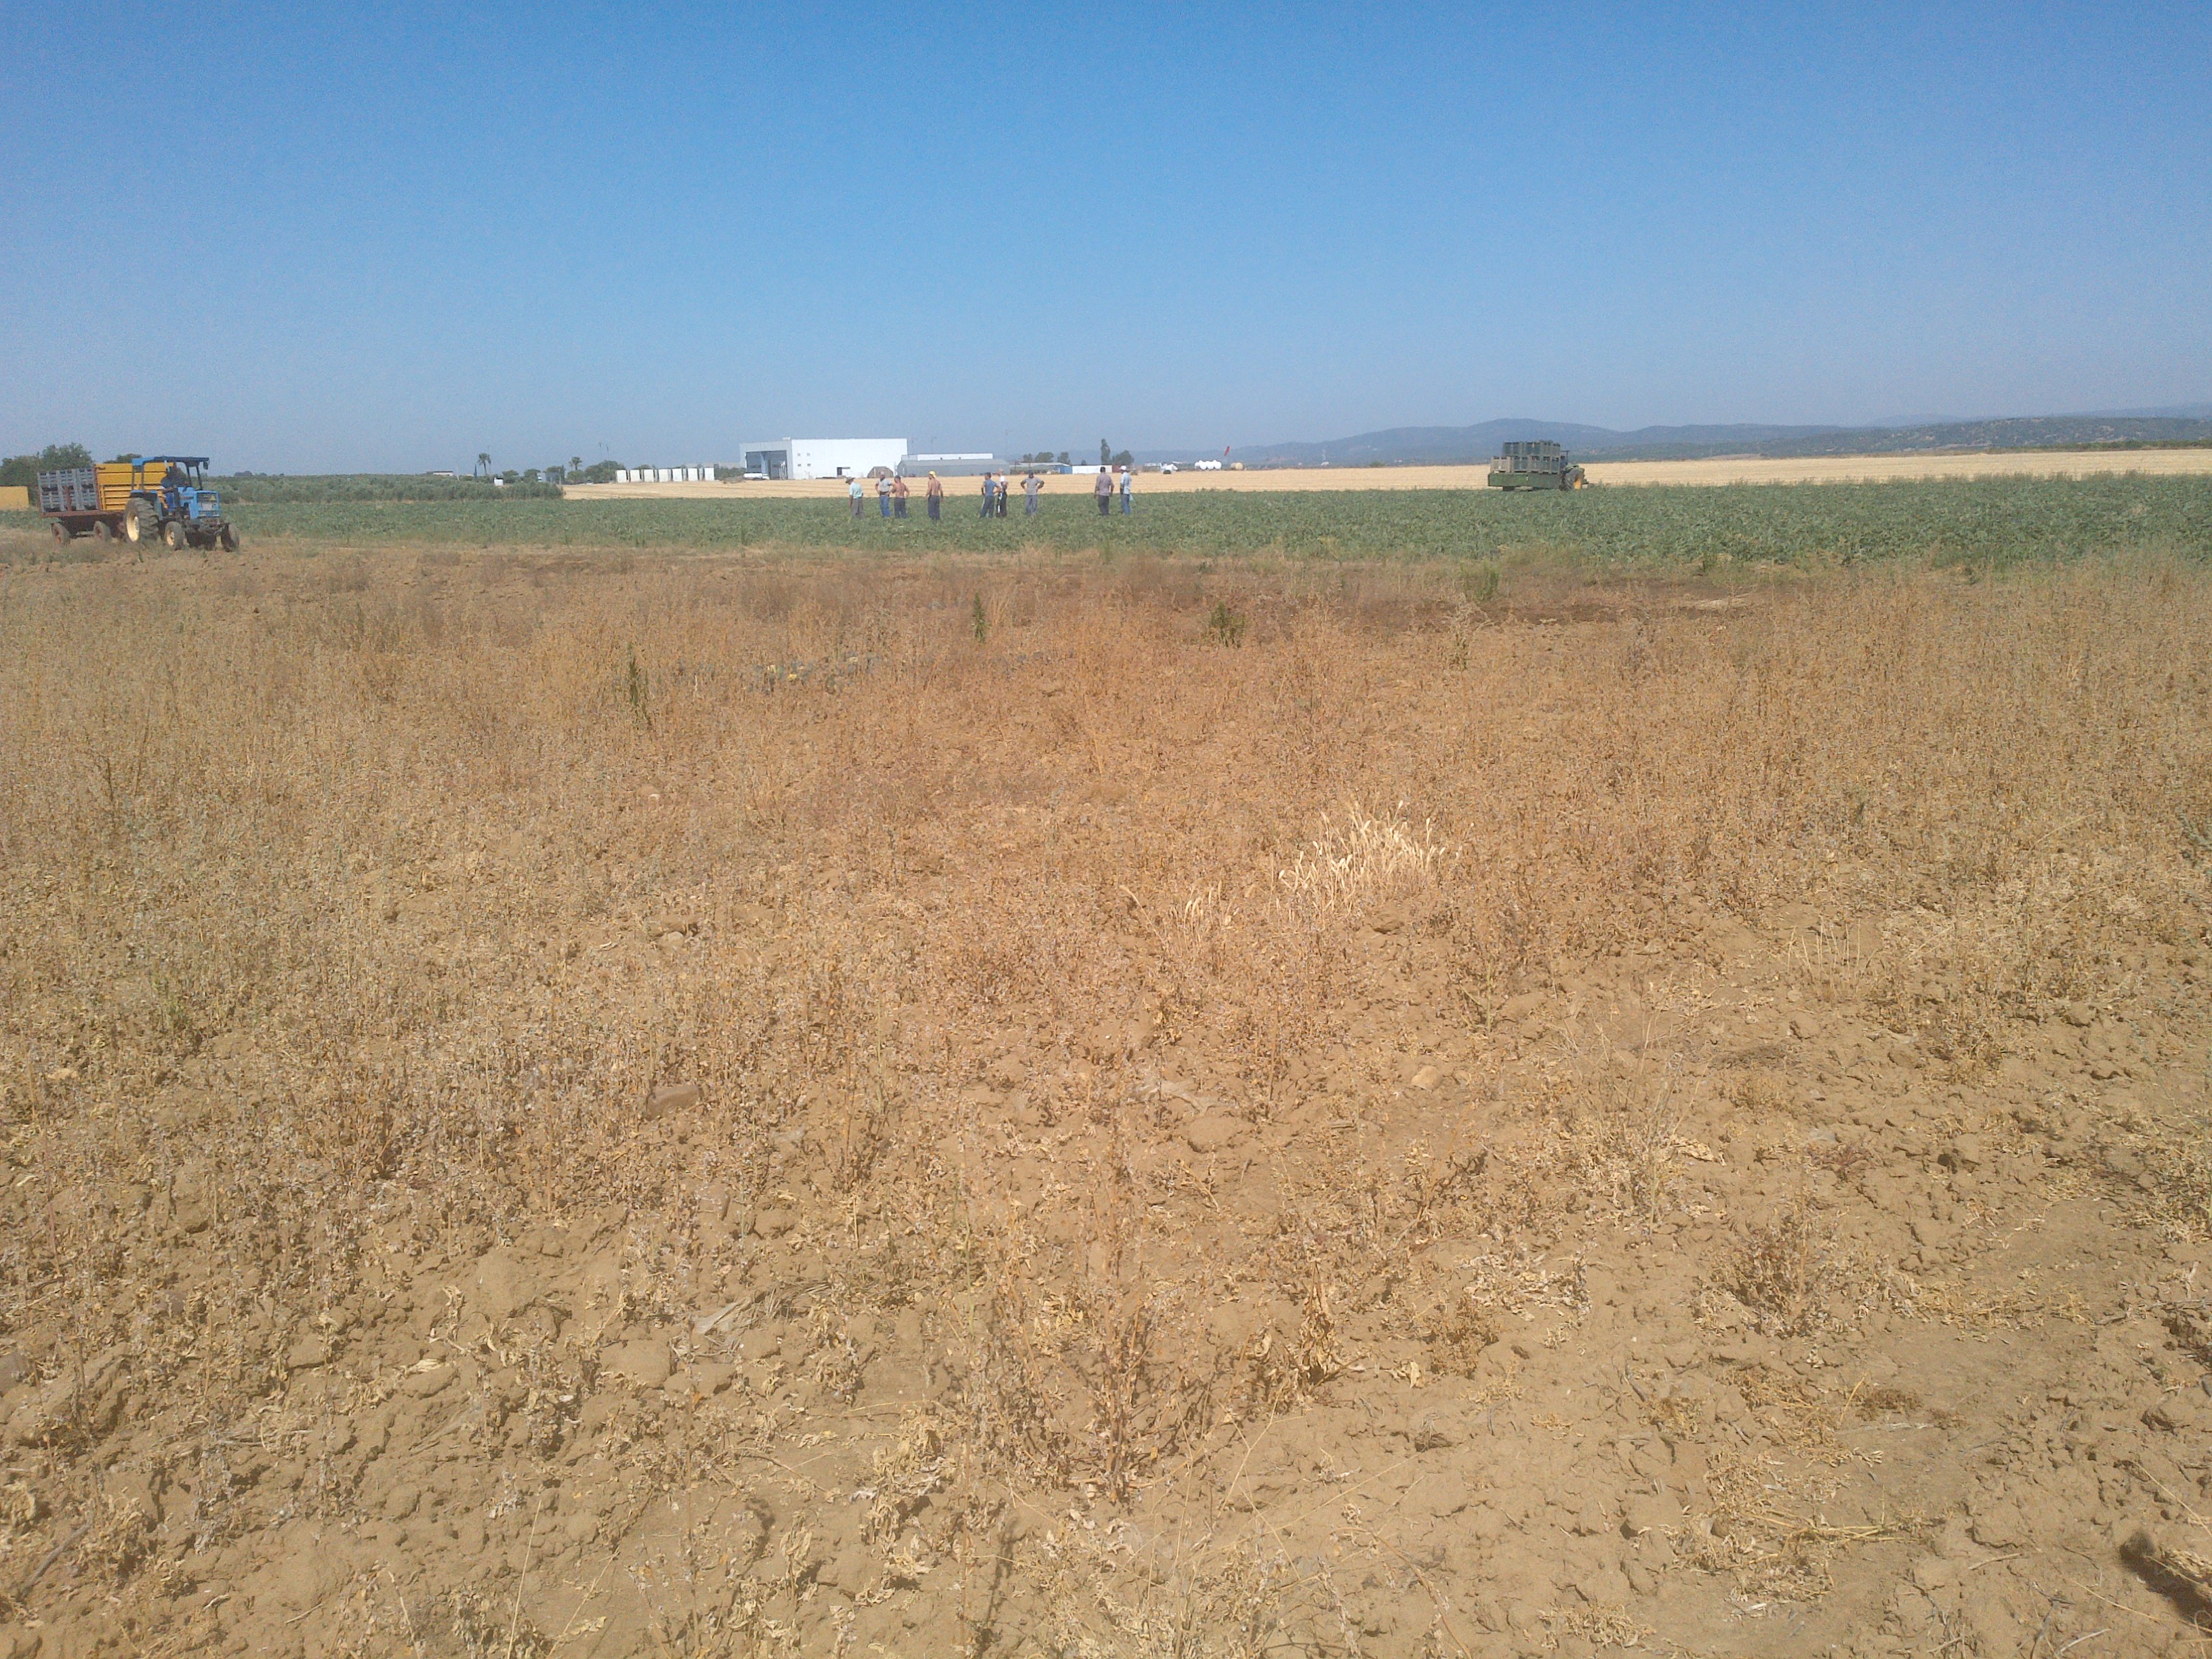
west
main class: Cropland
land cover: Olive groves
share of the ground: 50 - 75 %
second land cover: Spontaneously vegetated surfaces
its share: 10 - 25 %
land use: Agriculture (excluding fallow land and kitchen gardens)
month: June
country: ES
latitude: 37.7134
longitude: -5.2069
